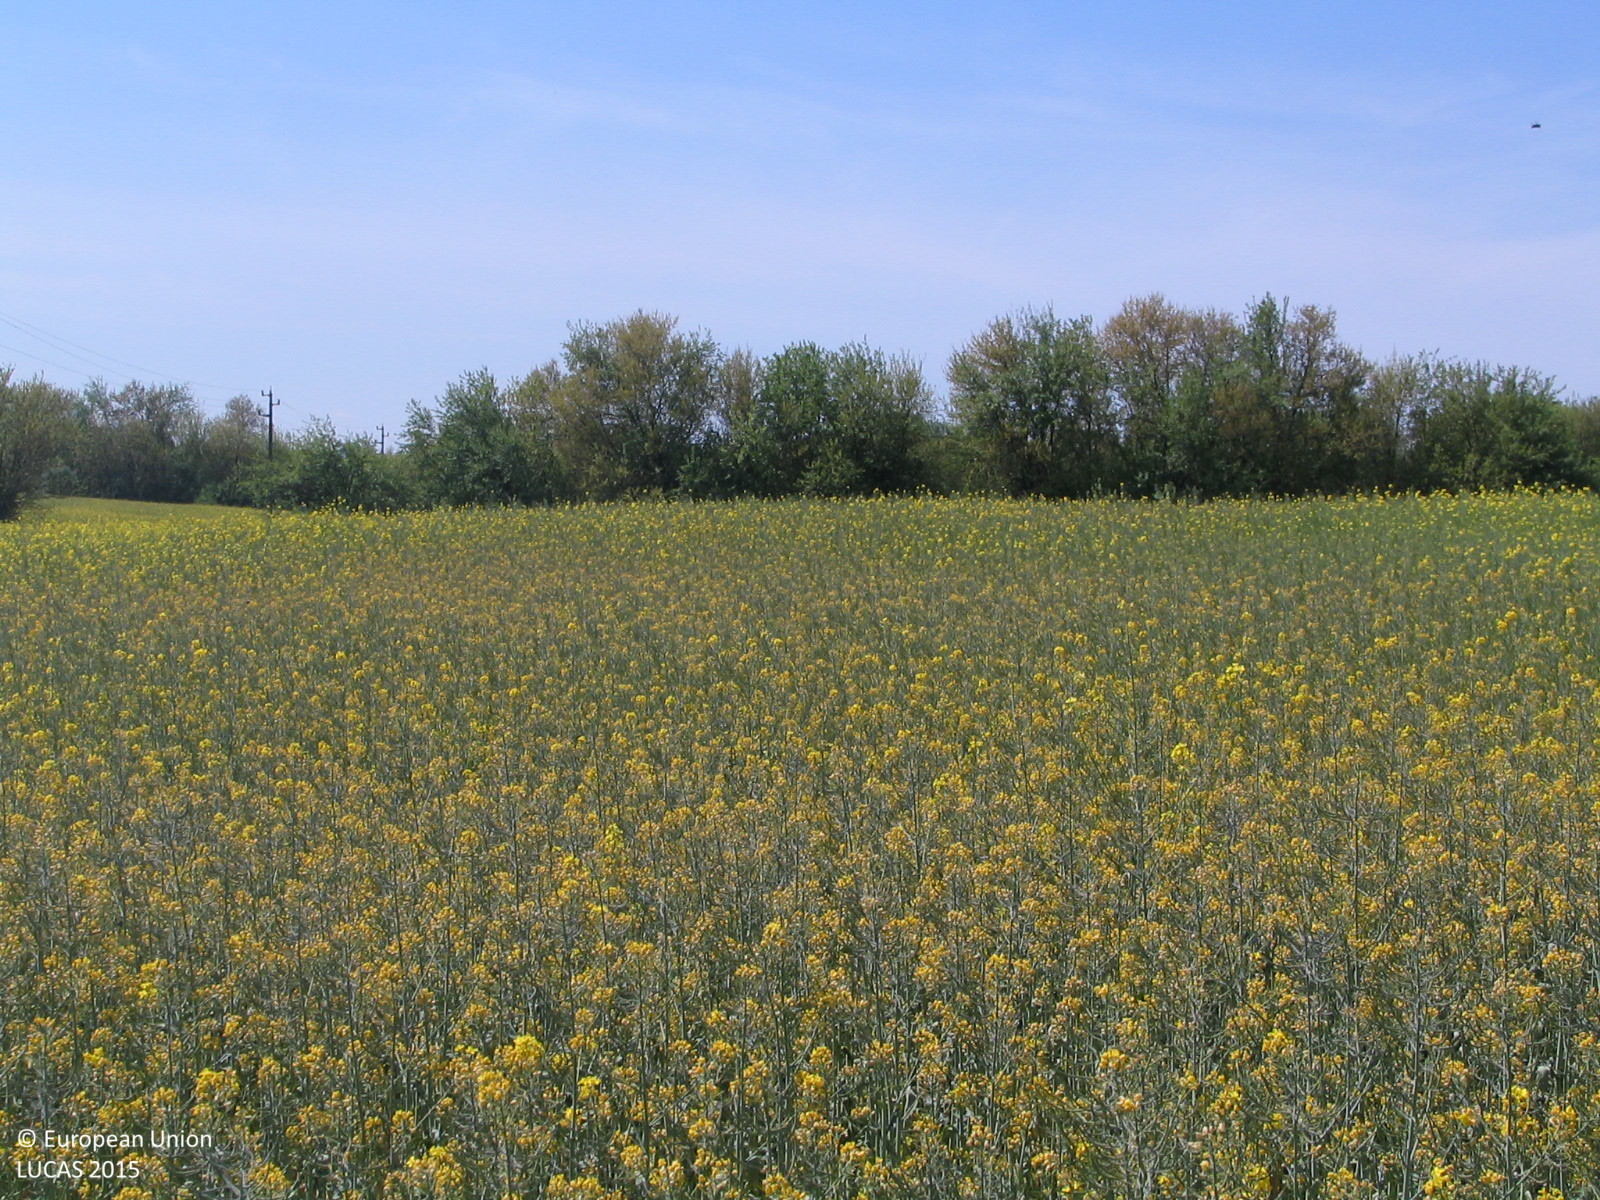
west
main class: Cropland
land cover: Rape and turnip rape
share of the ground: > 75 %
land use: Agriculture (excluding fallow land and kitchen gardens)
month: May
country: BG
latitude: 43.6946
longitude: 24.0889
